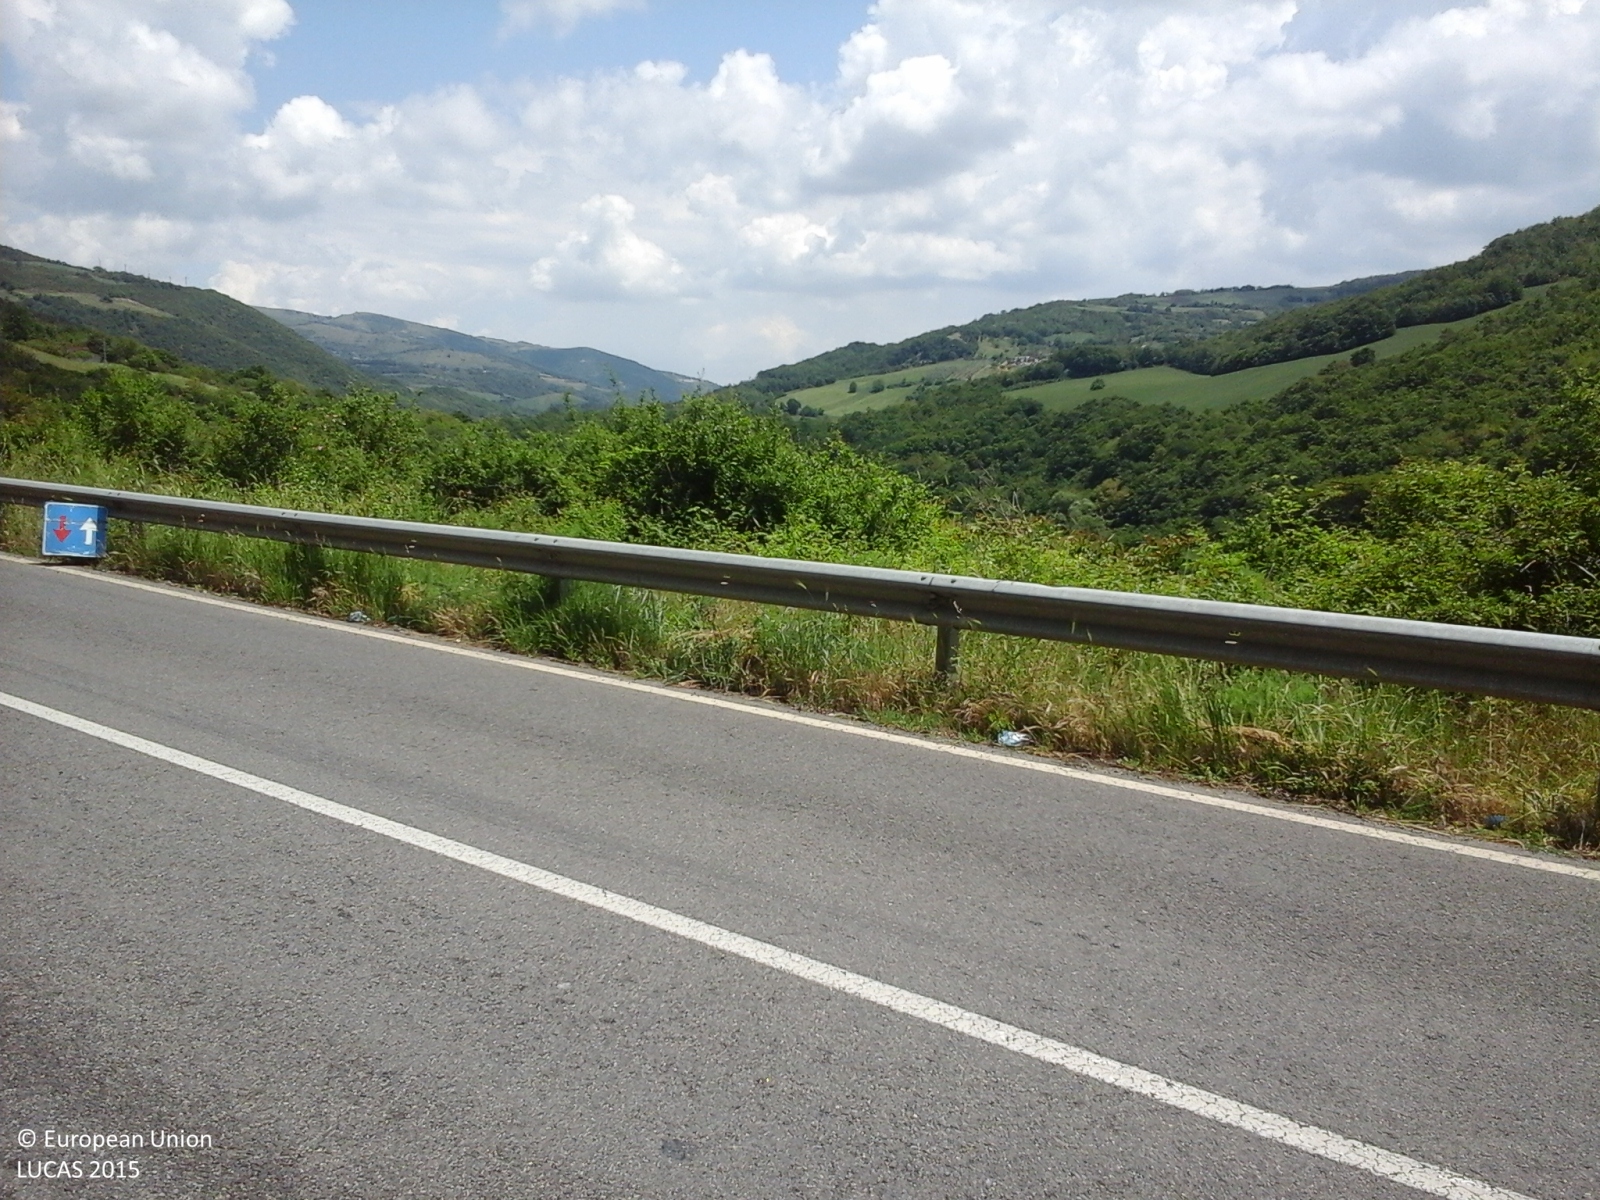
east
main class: Shrubland
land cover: Shrubland with sparse tree cover
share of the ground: > 75 %
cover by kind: shrubs 75 %, herbaceous plants 20 %, coniferous forest trees 5 %
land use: Semi-natural and natural areas not in use
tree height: > 5 m
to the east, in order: Shrubland with sparse tree cover; Fences; Grass margins; Artificial constructions; Paved roads, cycling and walking lanes; Grass margins; Shrubland with sparse tree cover; Grassland without tree/shrub cover; Abandoned hedges; Inland fresh running water; Dry stone walls; Shrubland without tree cover; Temporary grasslands
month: May
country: IT
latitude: 41.2365
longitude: 15.1716
